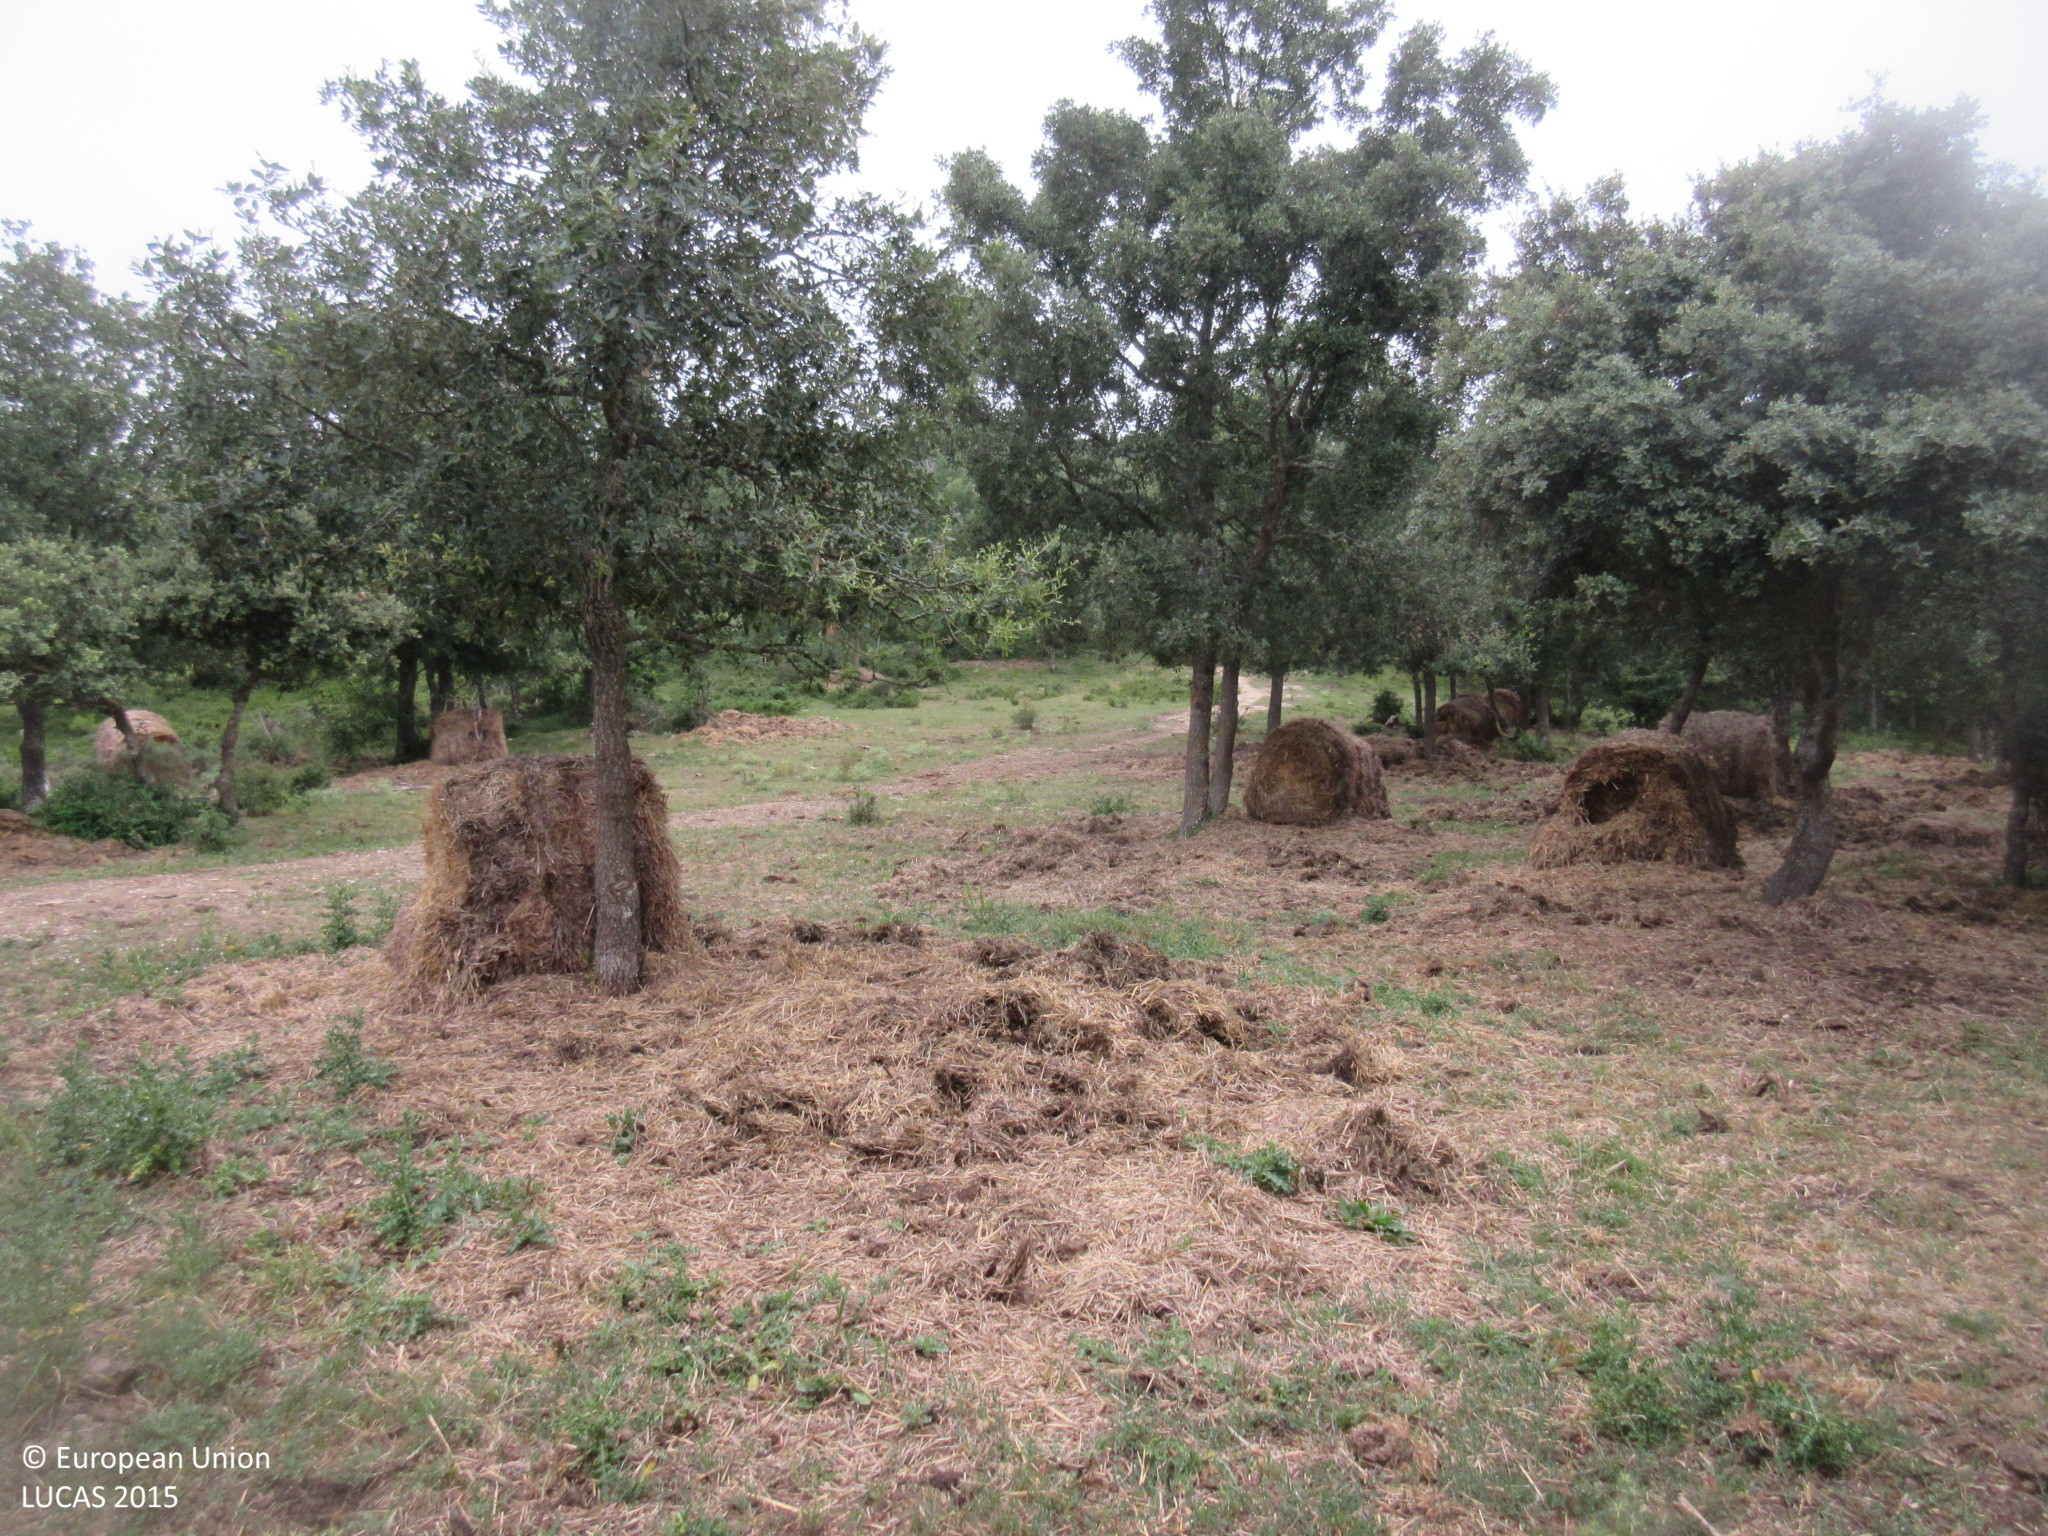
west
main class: Woodland
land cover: Broadleaved woodland
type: broadleaved evergreen forest
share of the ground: > 75 %
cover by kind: broadleaved forest trees 75 %, herbaceous plants 20 %, shrubs 5 %
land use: Agriculture (excluding fallow land and kitchen gardens)
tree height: > 5 m
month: July
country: ES
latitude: 43.0185
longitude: -3.5505
